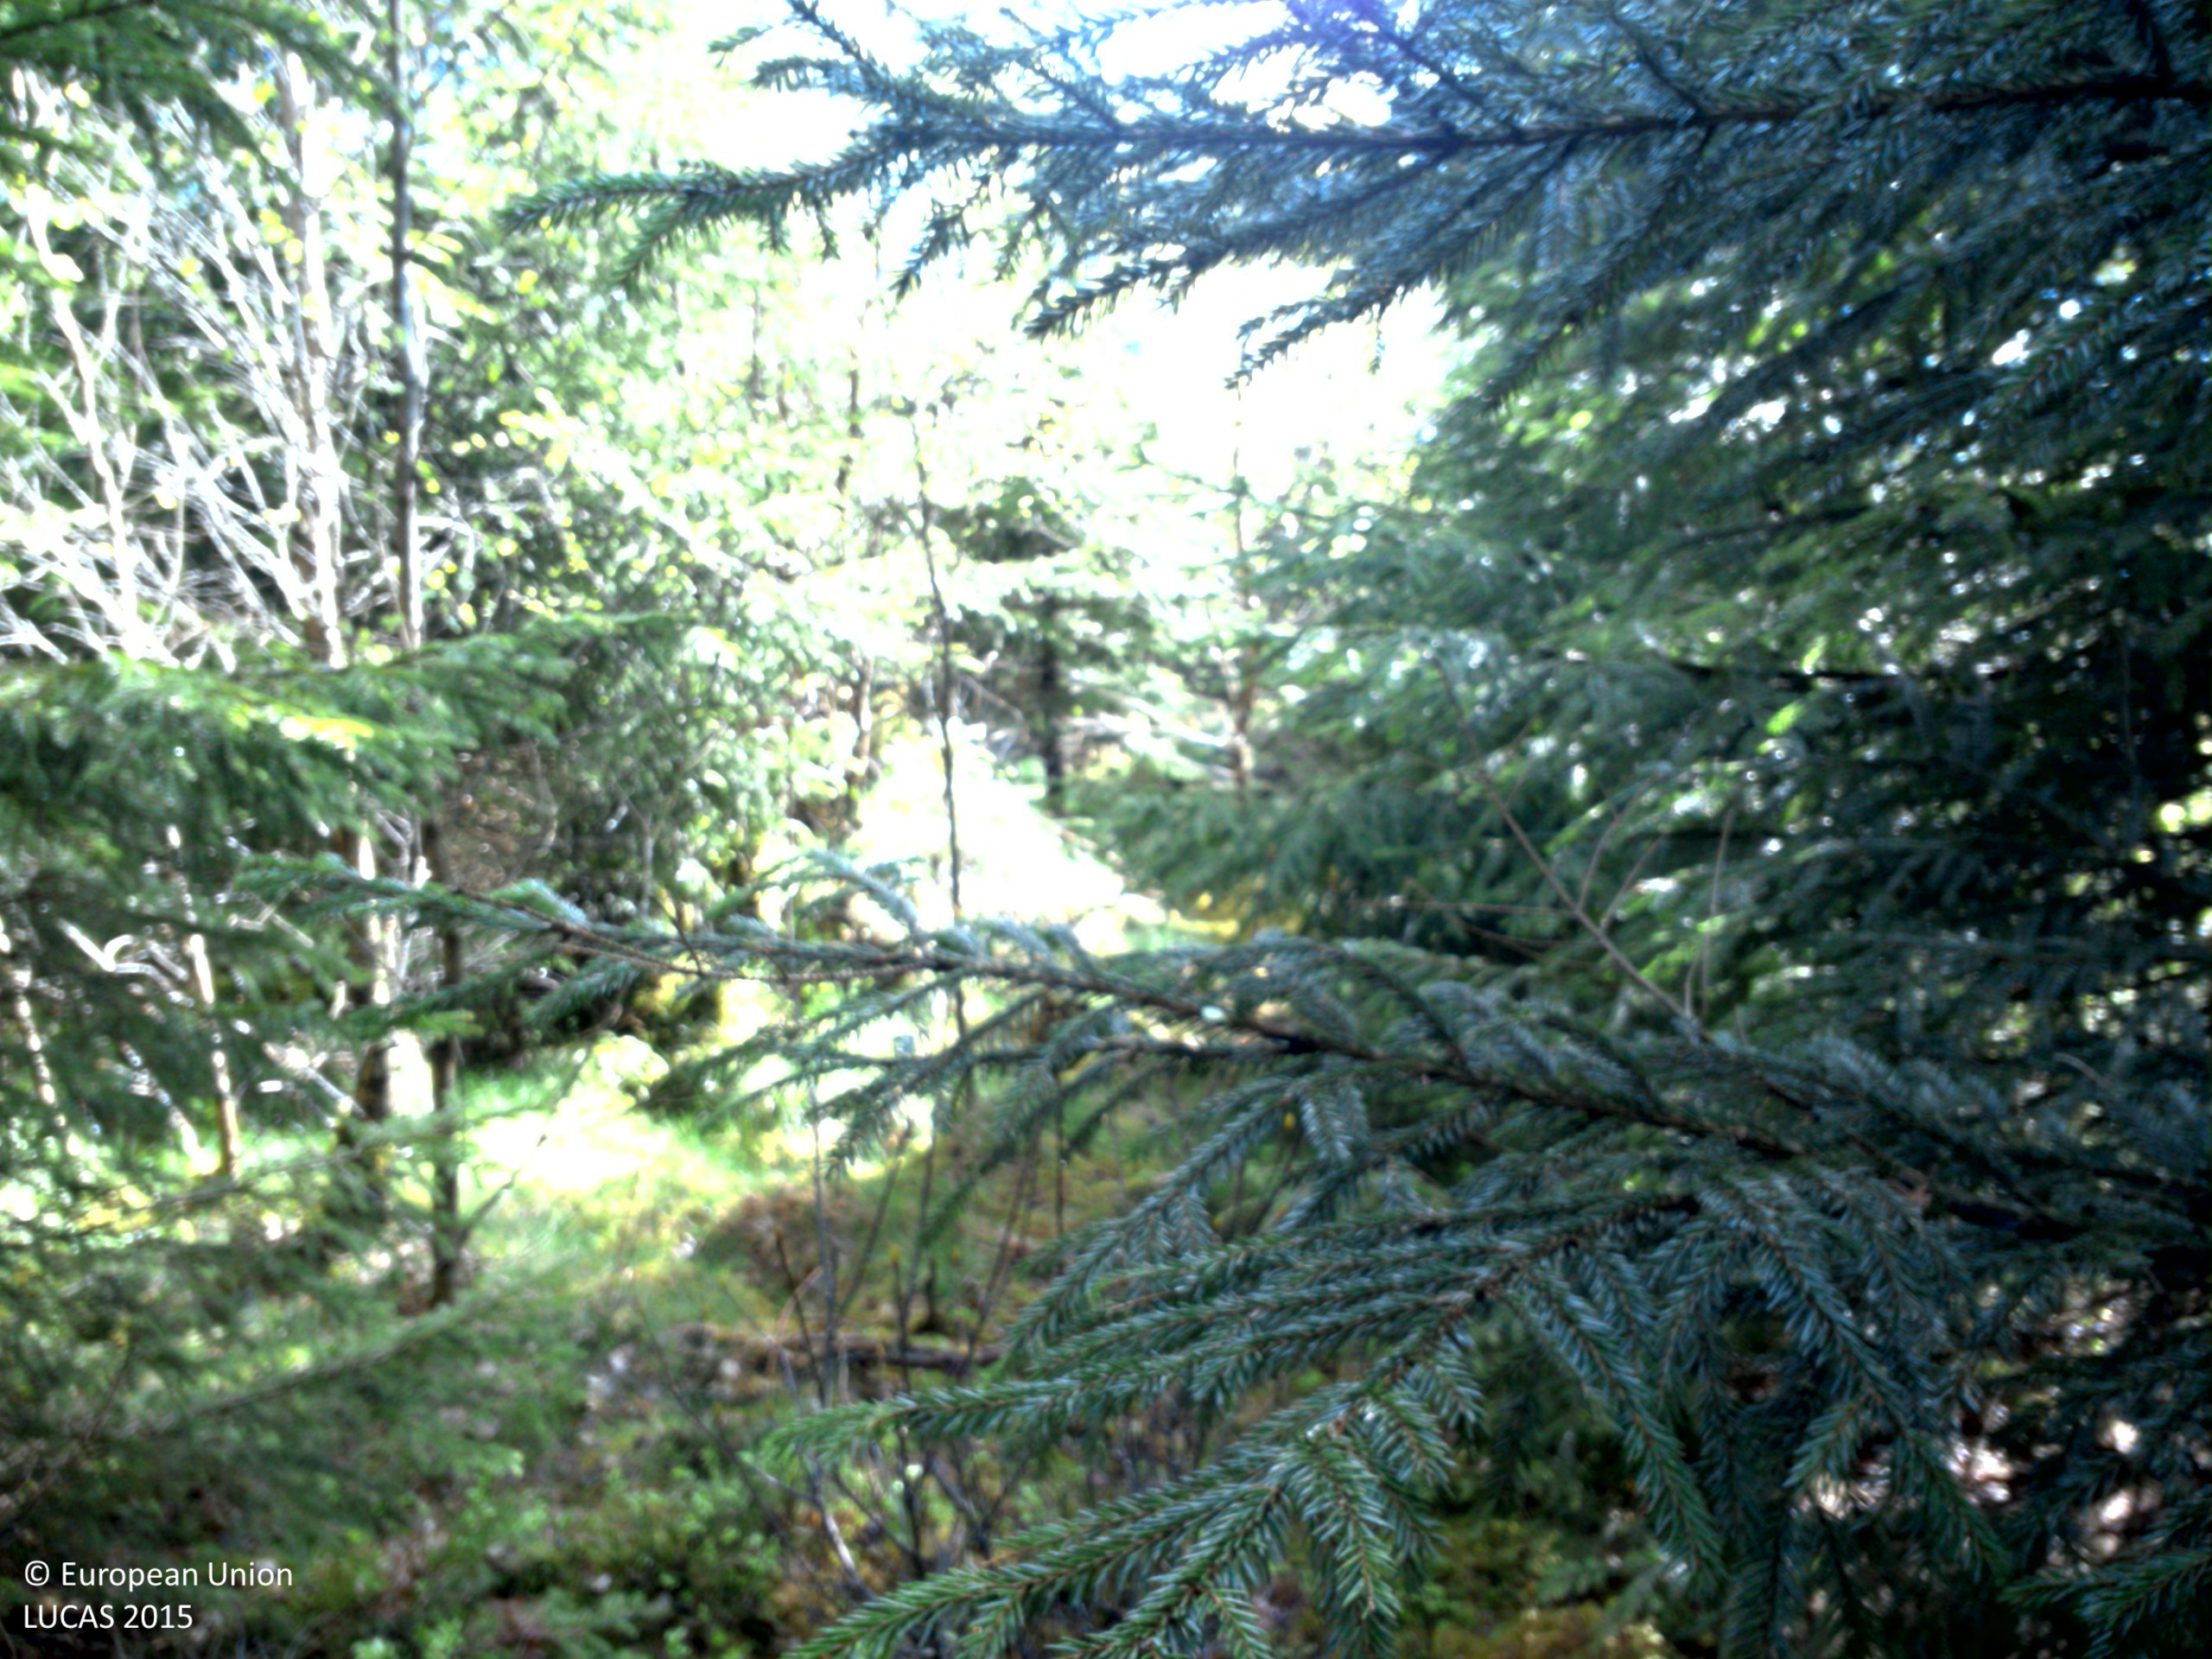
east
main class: Woodland
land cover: Spruce dominated coniferous woodland
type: boreal forest
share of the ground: > 75 %
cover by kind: coniferous forest trees 90 %, broadleaved forest trees 5 %, lichens and mosses 5 %
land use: Forestry
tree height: > 5 m
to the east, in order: Spruce dominated coniferous woodland; Shrubland without tree cover; Spruce dominated mixed woodland; Broadleaved woodland; Electric lines
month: May
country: SE
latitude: 57.6814
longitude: 13.0310
